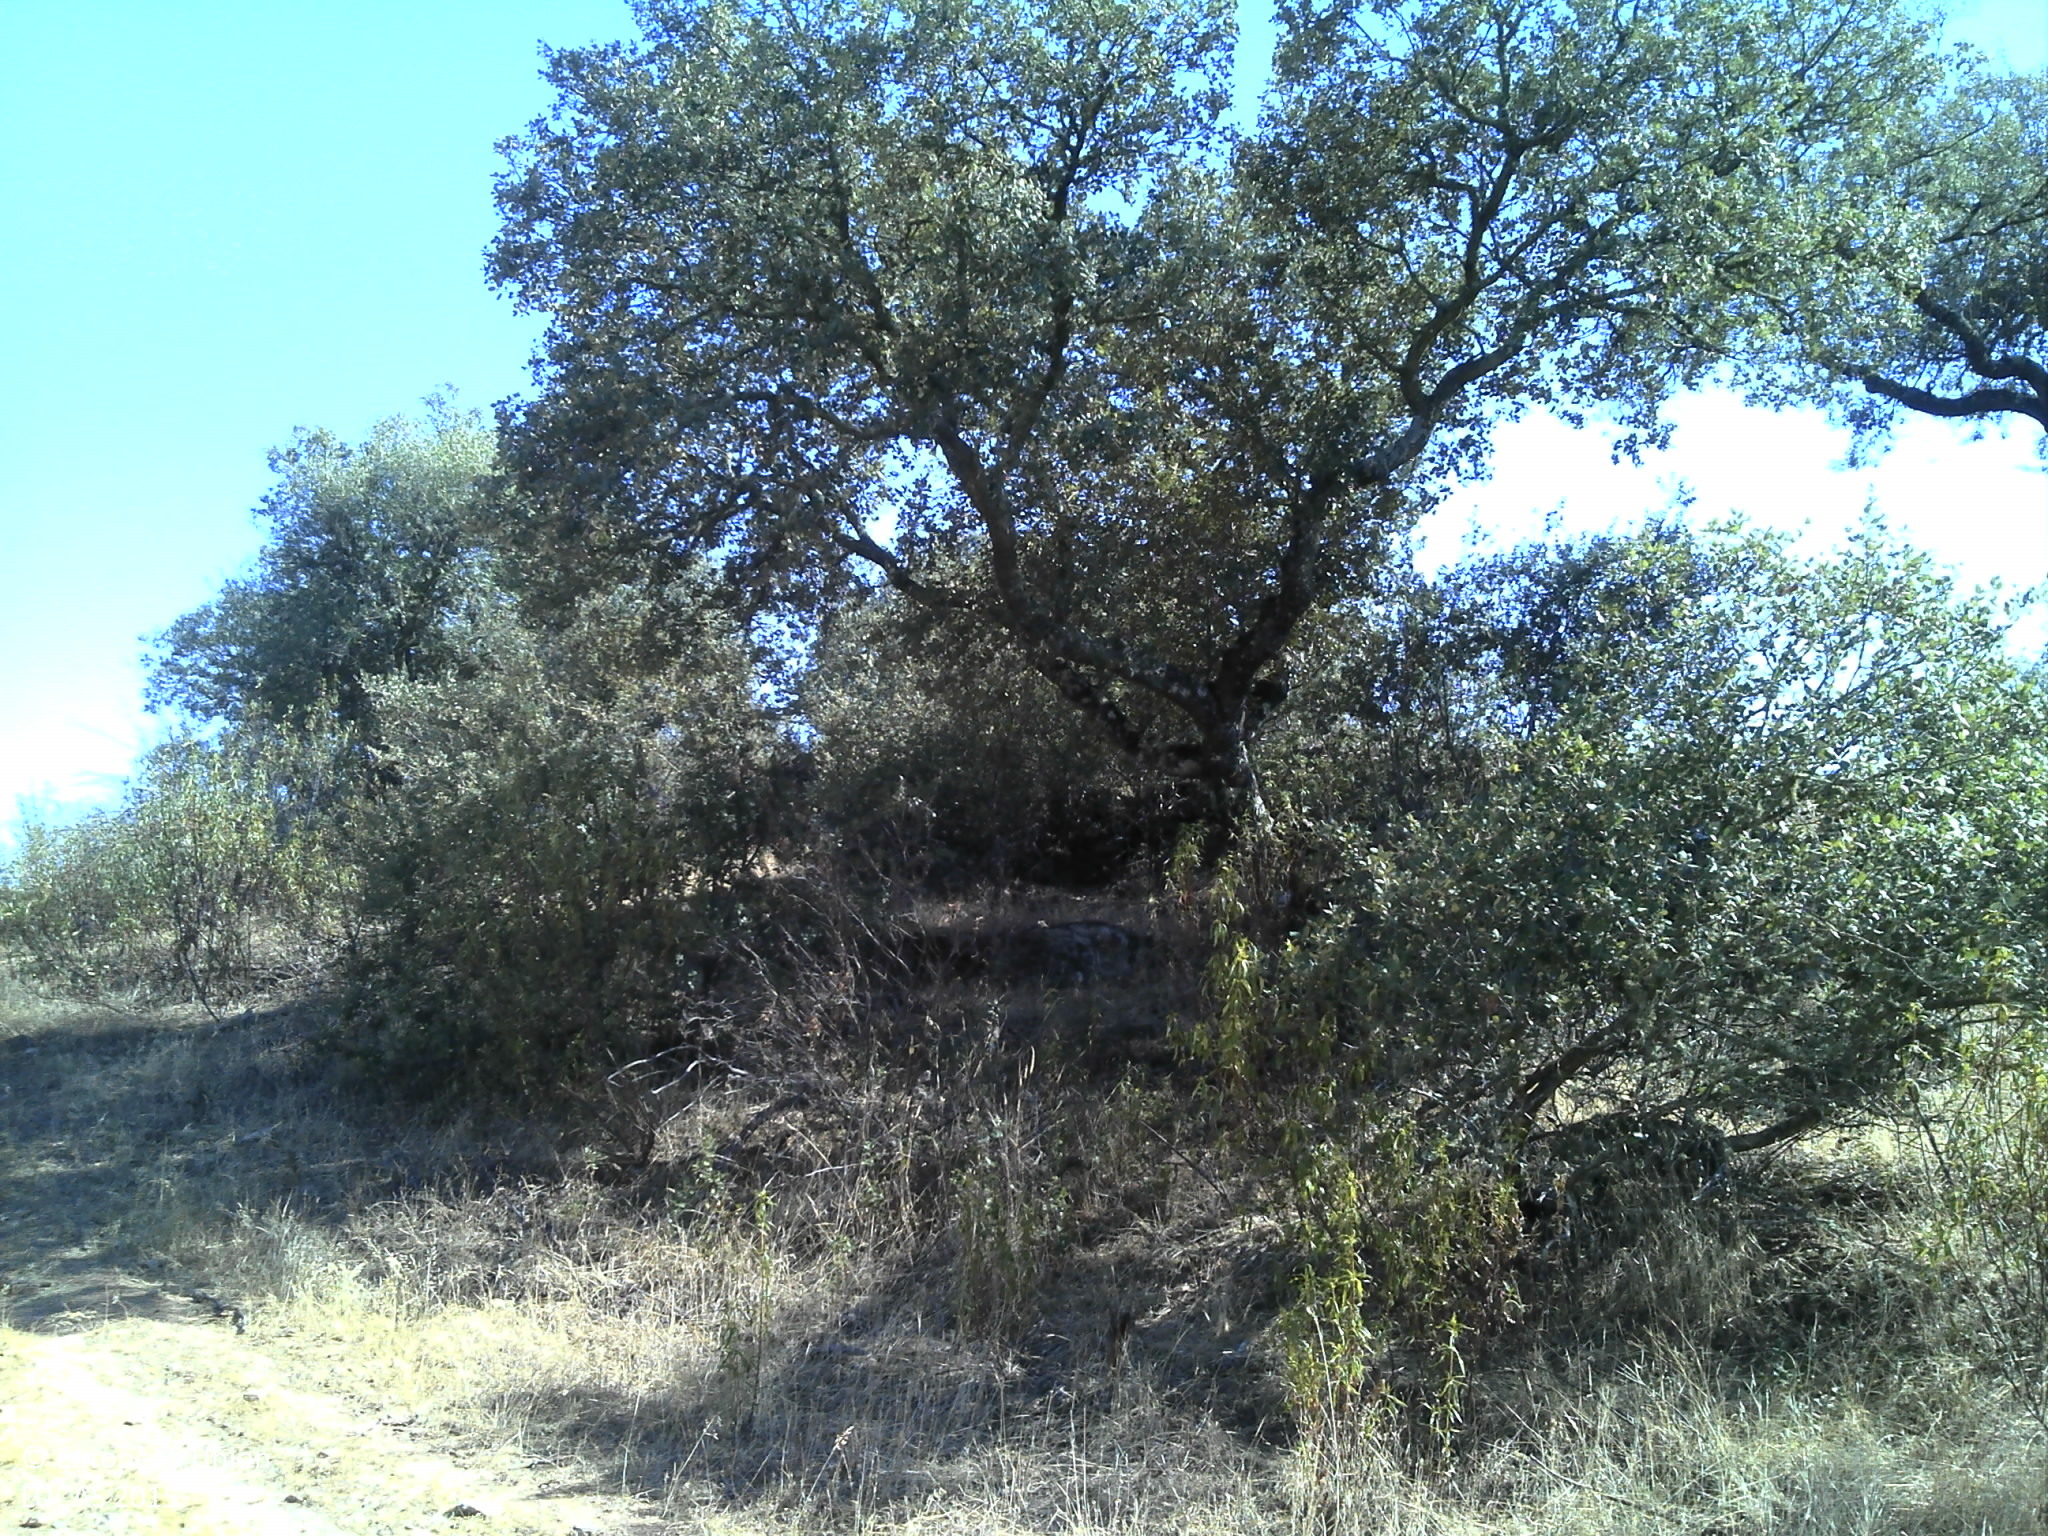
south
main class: Woodland
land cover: Broadleaved woodland
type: broadleaved evergreen forest
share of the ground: 10 - 25 %
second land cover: Grassland without tree/shrub cover
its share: 50 - 75 %
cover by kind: herbaceous plants 60 %, unconsolidated bare surface 25 %, broadleaved forest trees 10 %, shrubs 5 %
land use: Forestry
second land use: Agriculture (excluding fallow land and kitchen gardens)
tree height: > 5 m
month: July
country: PT
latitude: 38.5833
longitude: -7.3260
